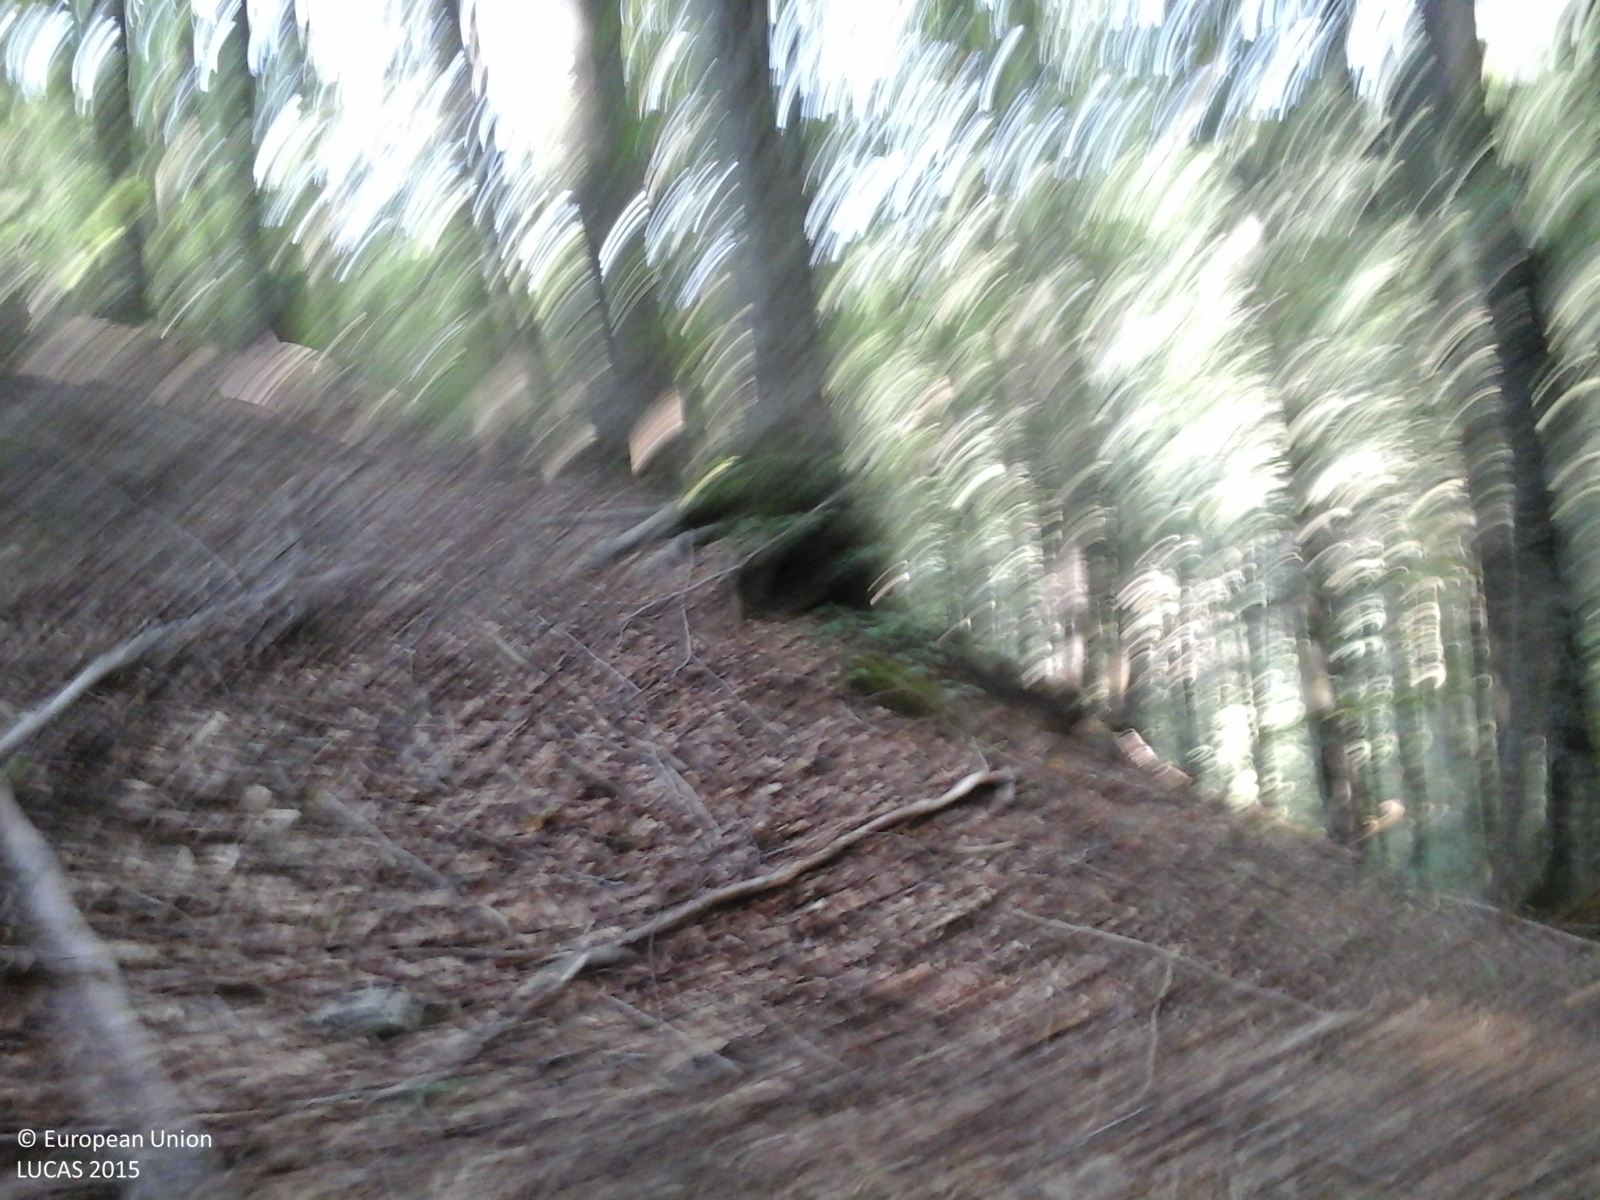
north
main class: Woodland
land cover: Broadleaved woodland
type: mountainous beech forest
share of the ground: > 75 %
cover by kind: broadleaved forest trees 90 %, lichens and mosses 10 %
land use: Semi-natural and natural areas not in use
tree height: > 5 m
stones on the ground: < 10 %
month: August
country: IT
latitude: 43.8108
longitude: 11.8476
